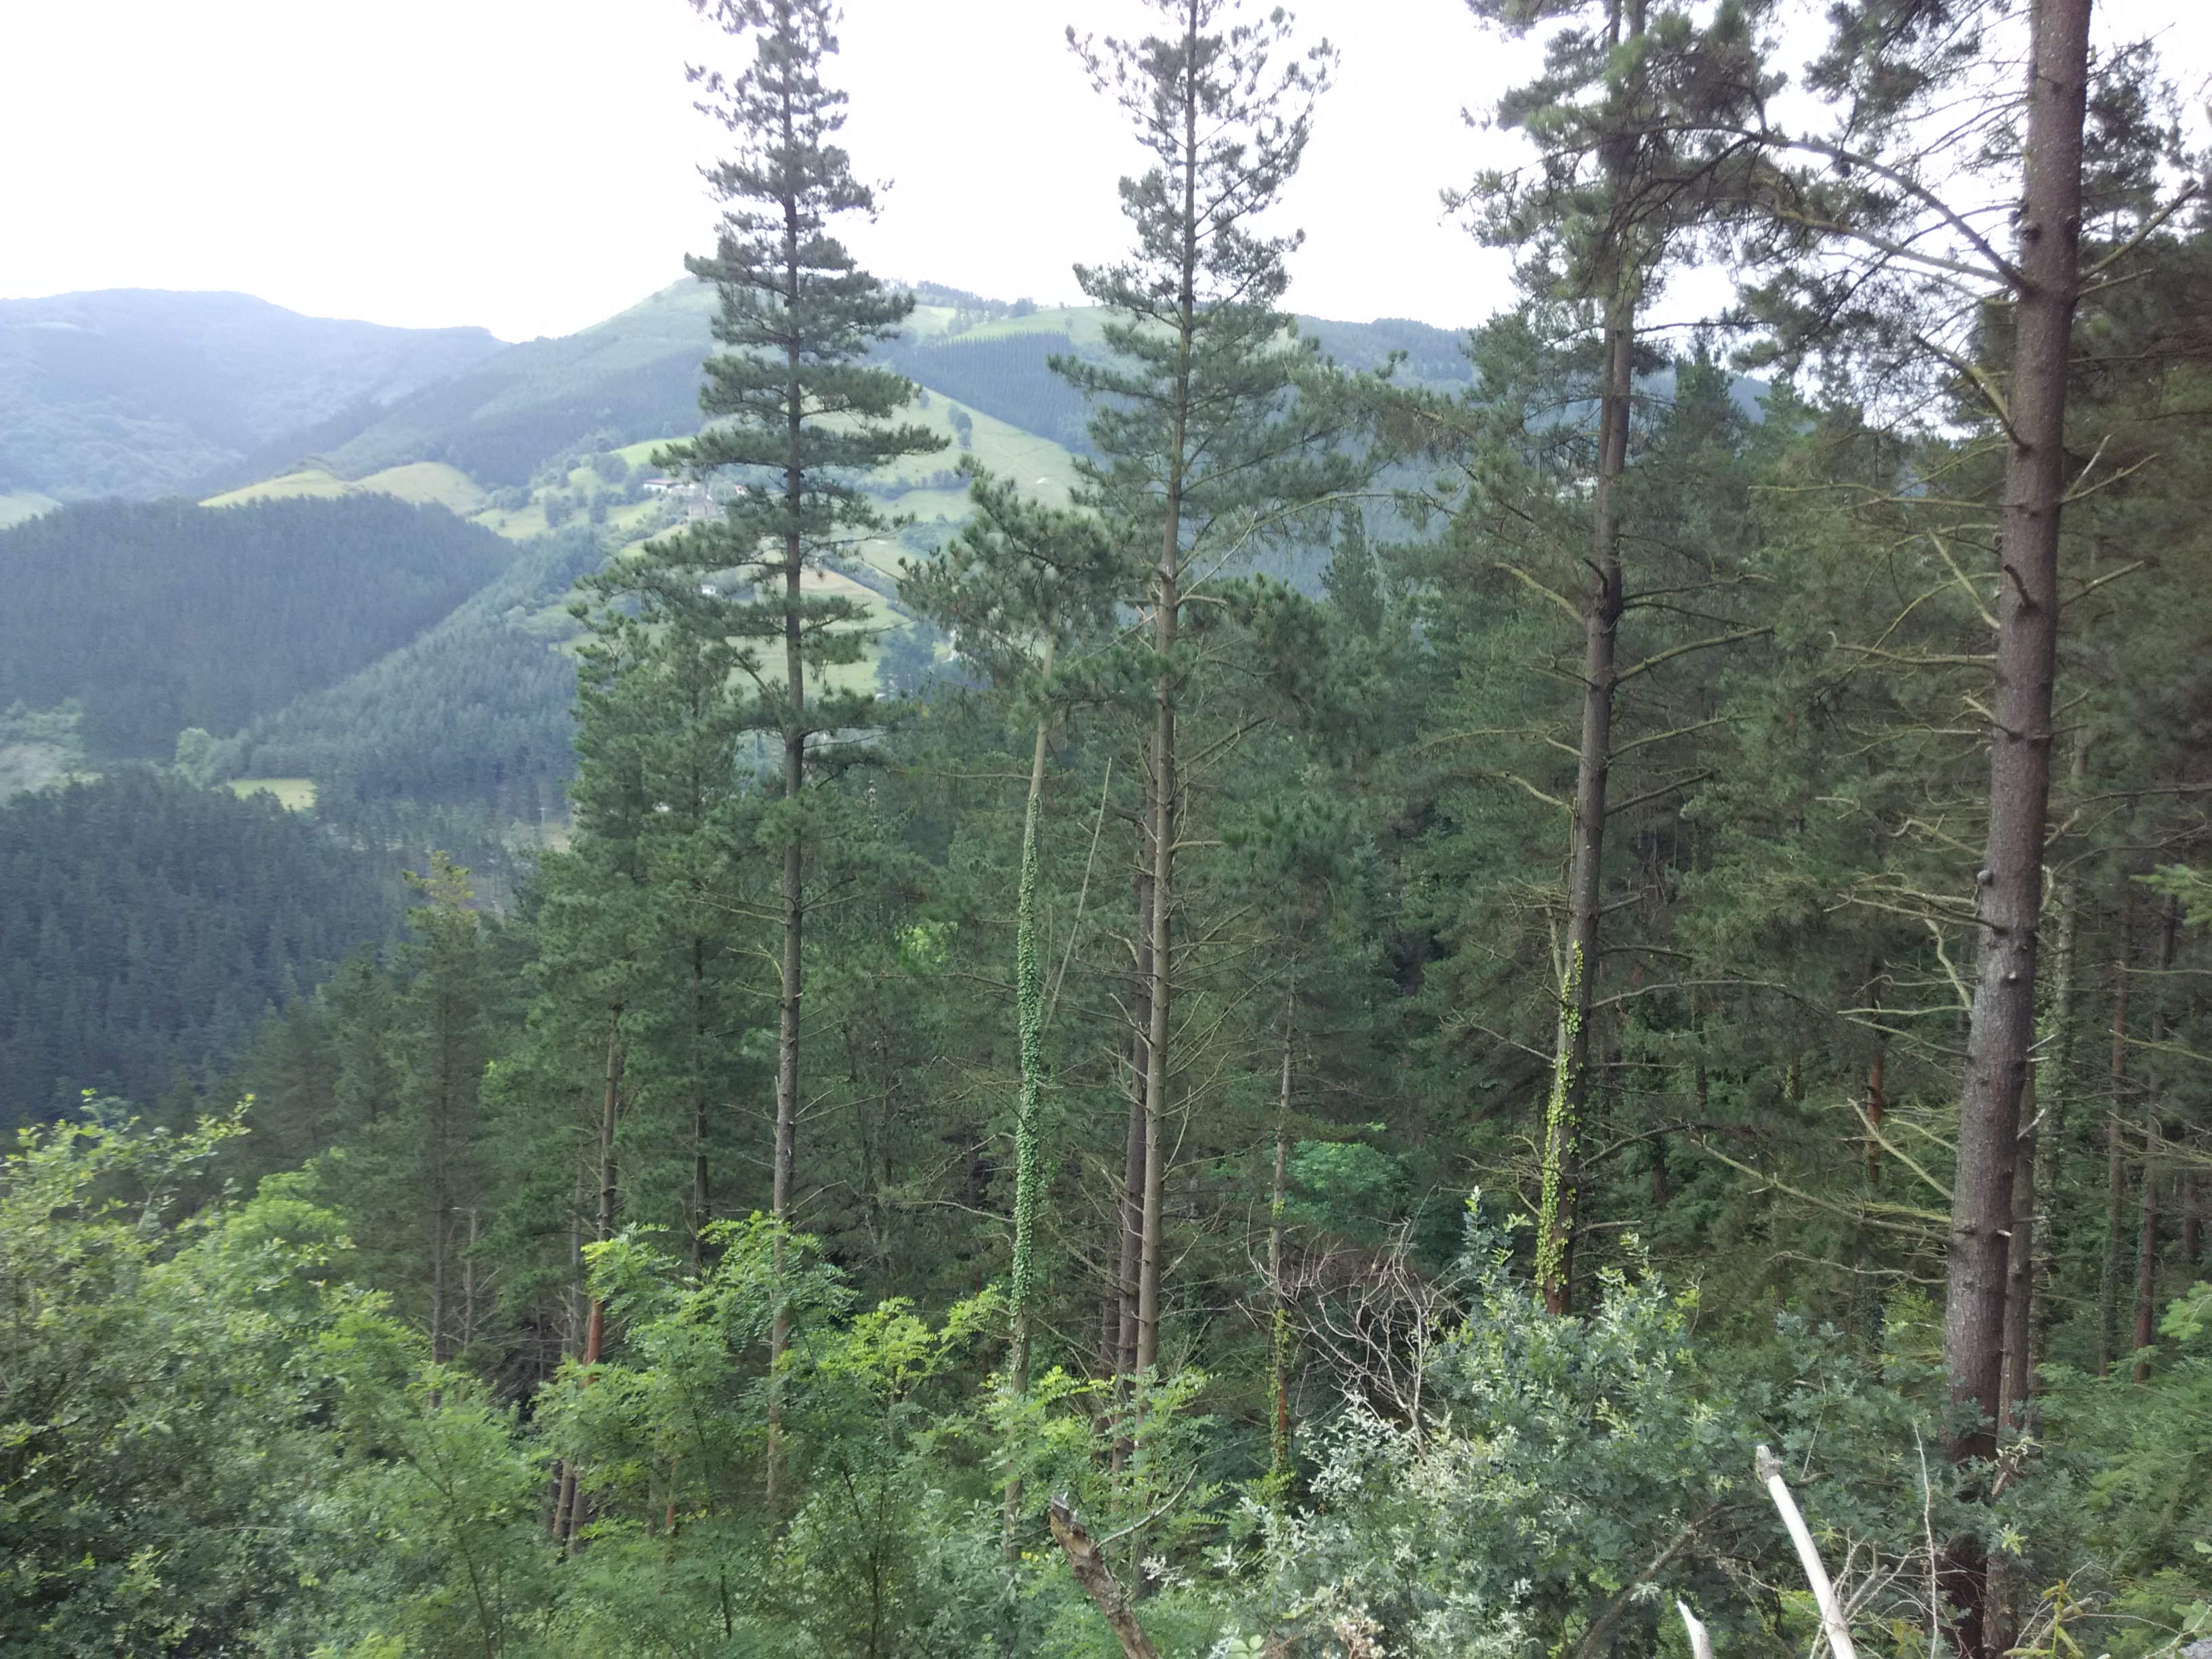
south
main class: Woodland
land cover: Pine dominated coniferous woodland
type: exotic forest
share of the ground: > 75 %
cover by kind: coniferous forest trees 100 %
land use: Forestry
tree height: > 5 m
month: July
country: ES
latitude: 43.0875
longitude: -2.4454
